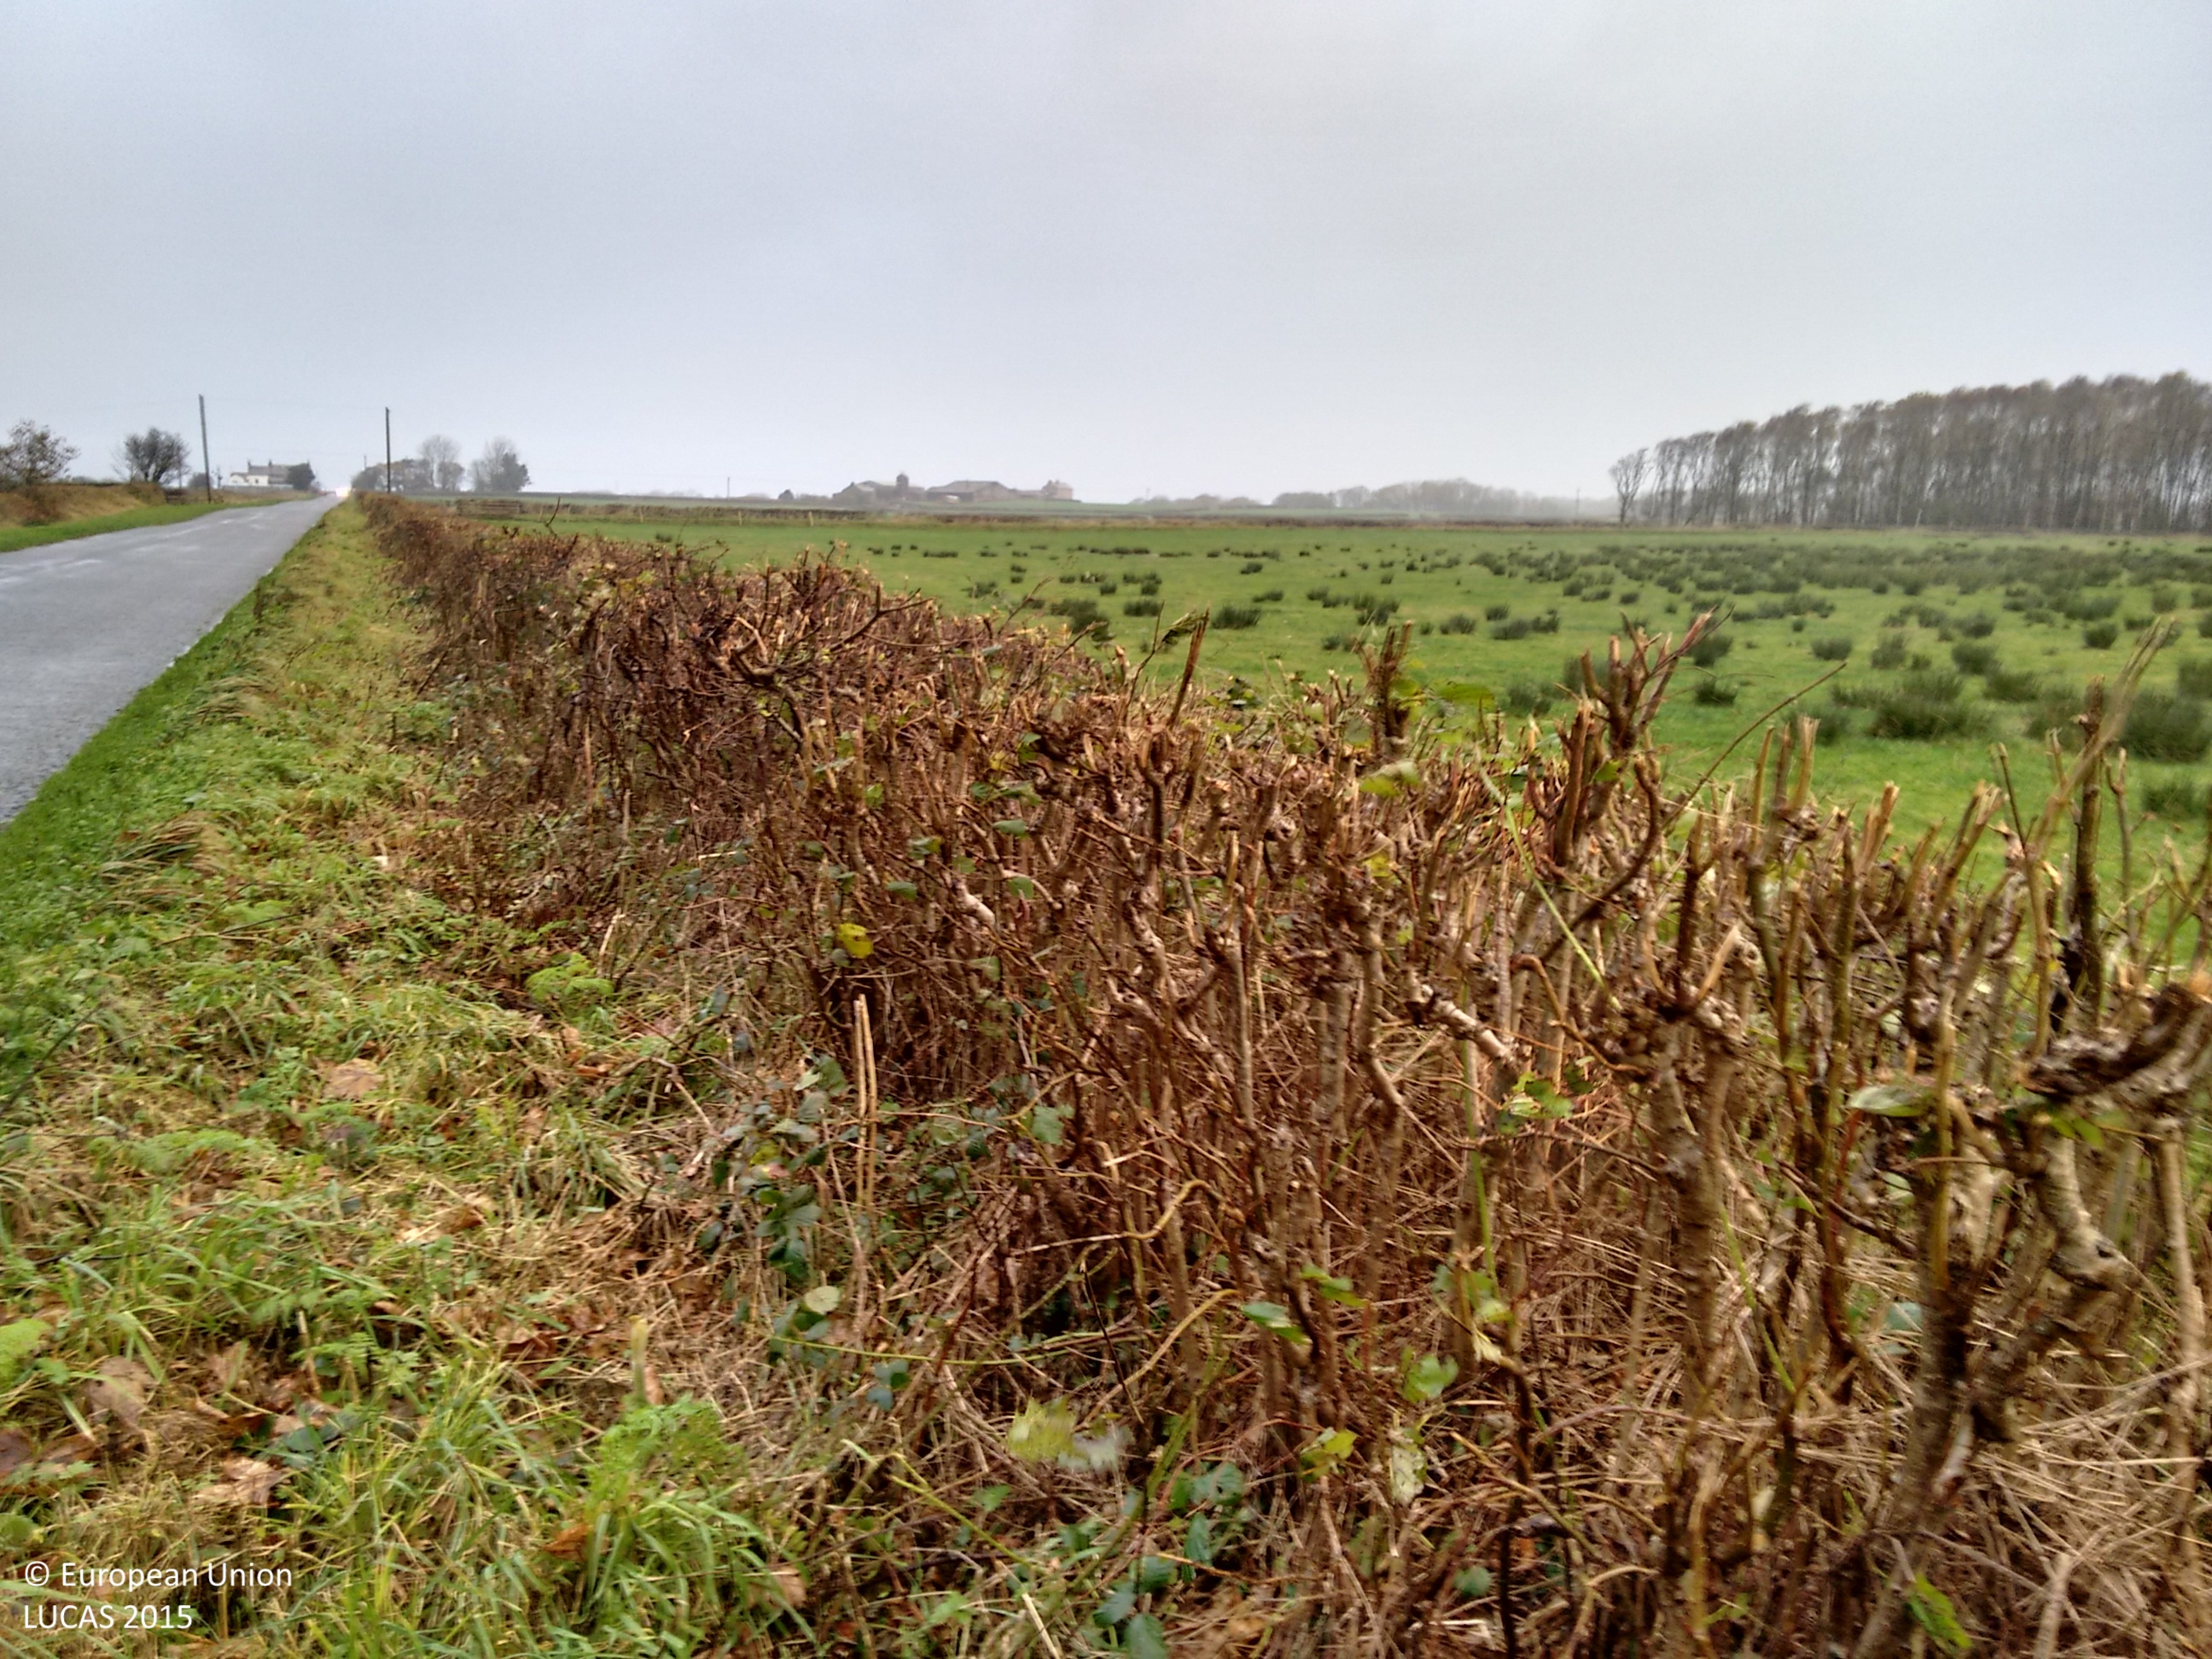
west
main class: Grassland
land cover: Grassland without tree/shrub cover
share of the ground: > 75 %
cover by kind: herbaceous plants 100 %
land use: Agriculture (excluding fallow land and kitchen gardens)
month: November
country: GB
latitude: 54.3857
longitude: -3.3998
